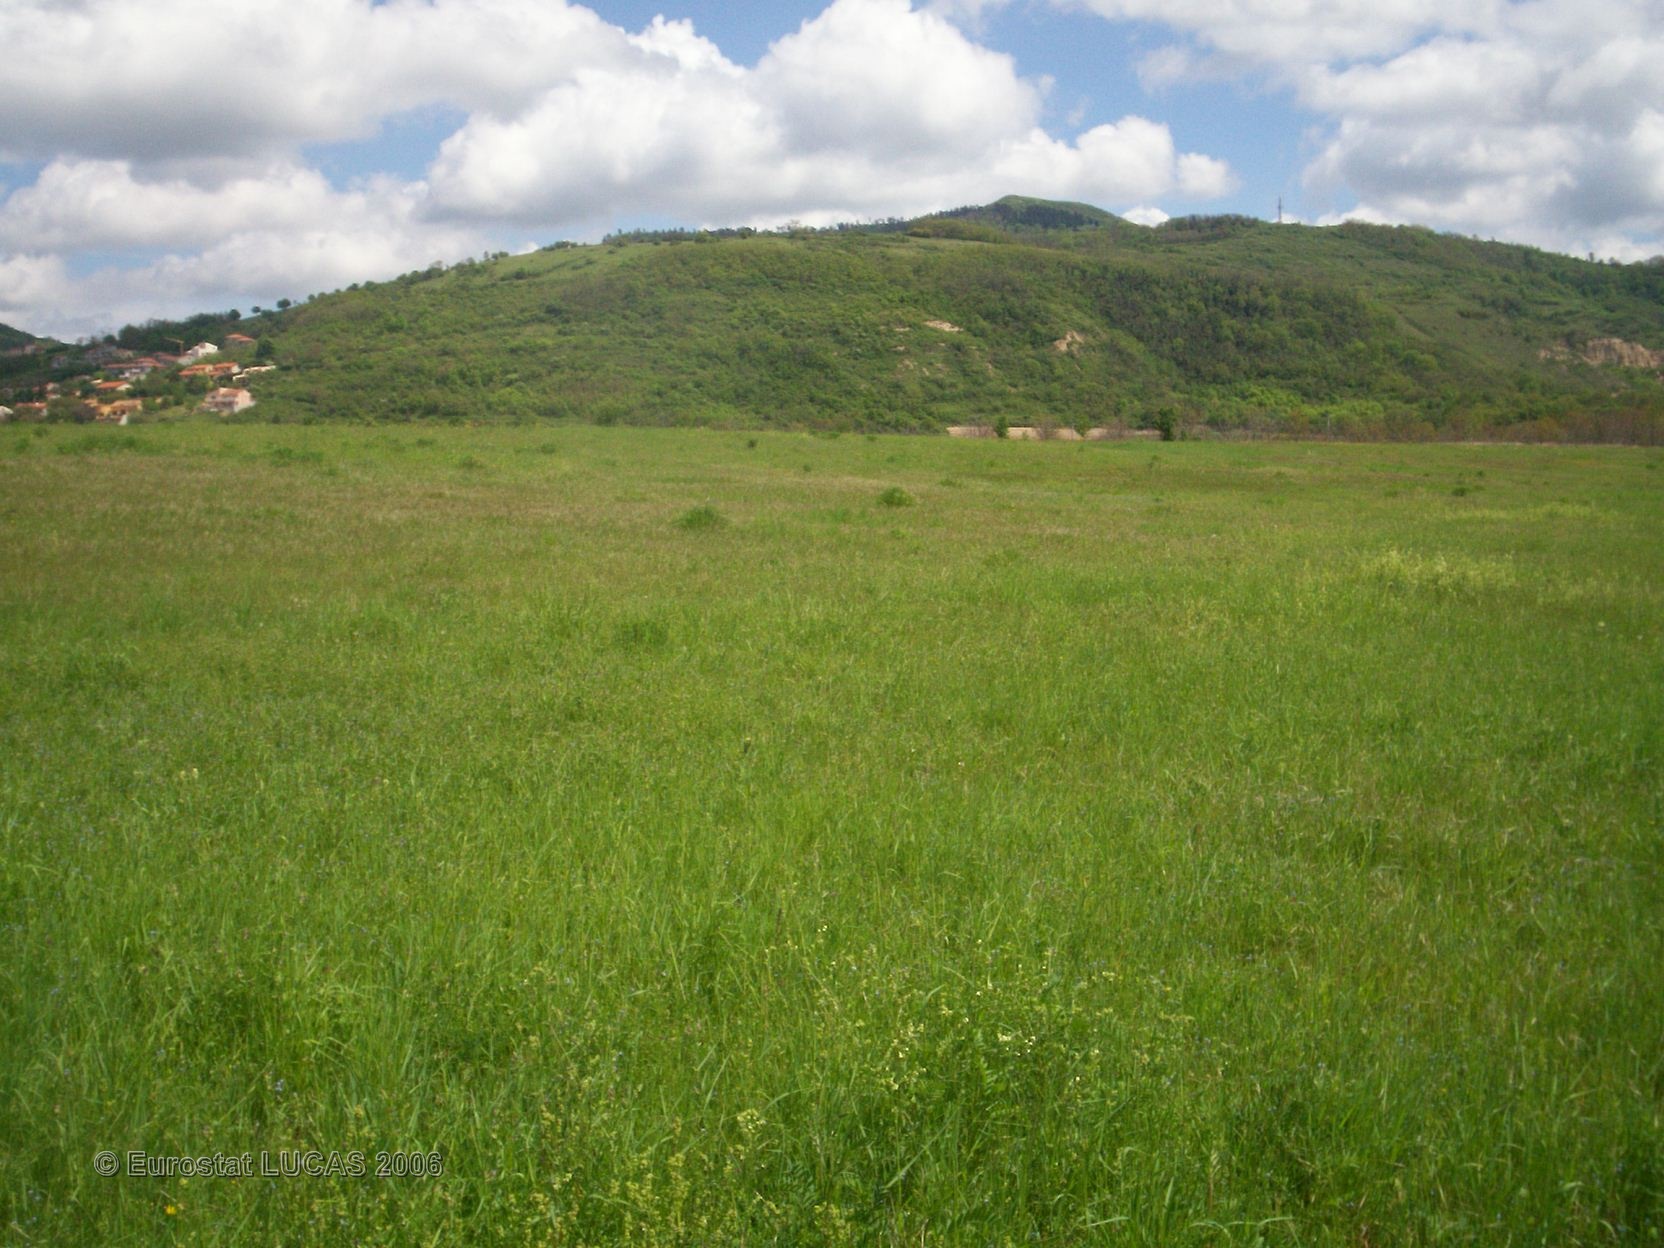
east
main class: Grassland
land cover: Grassland without tree/shrub cover
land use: Agriculture (excluding fallow land and kitchen gardens)
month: May
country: FR
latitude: 45.6834
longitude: 3.2084
